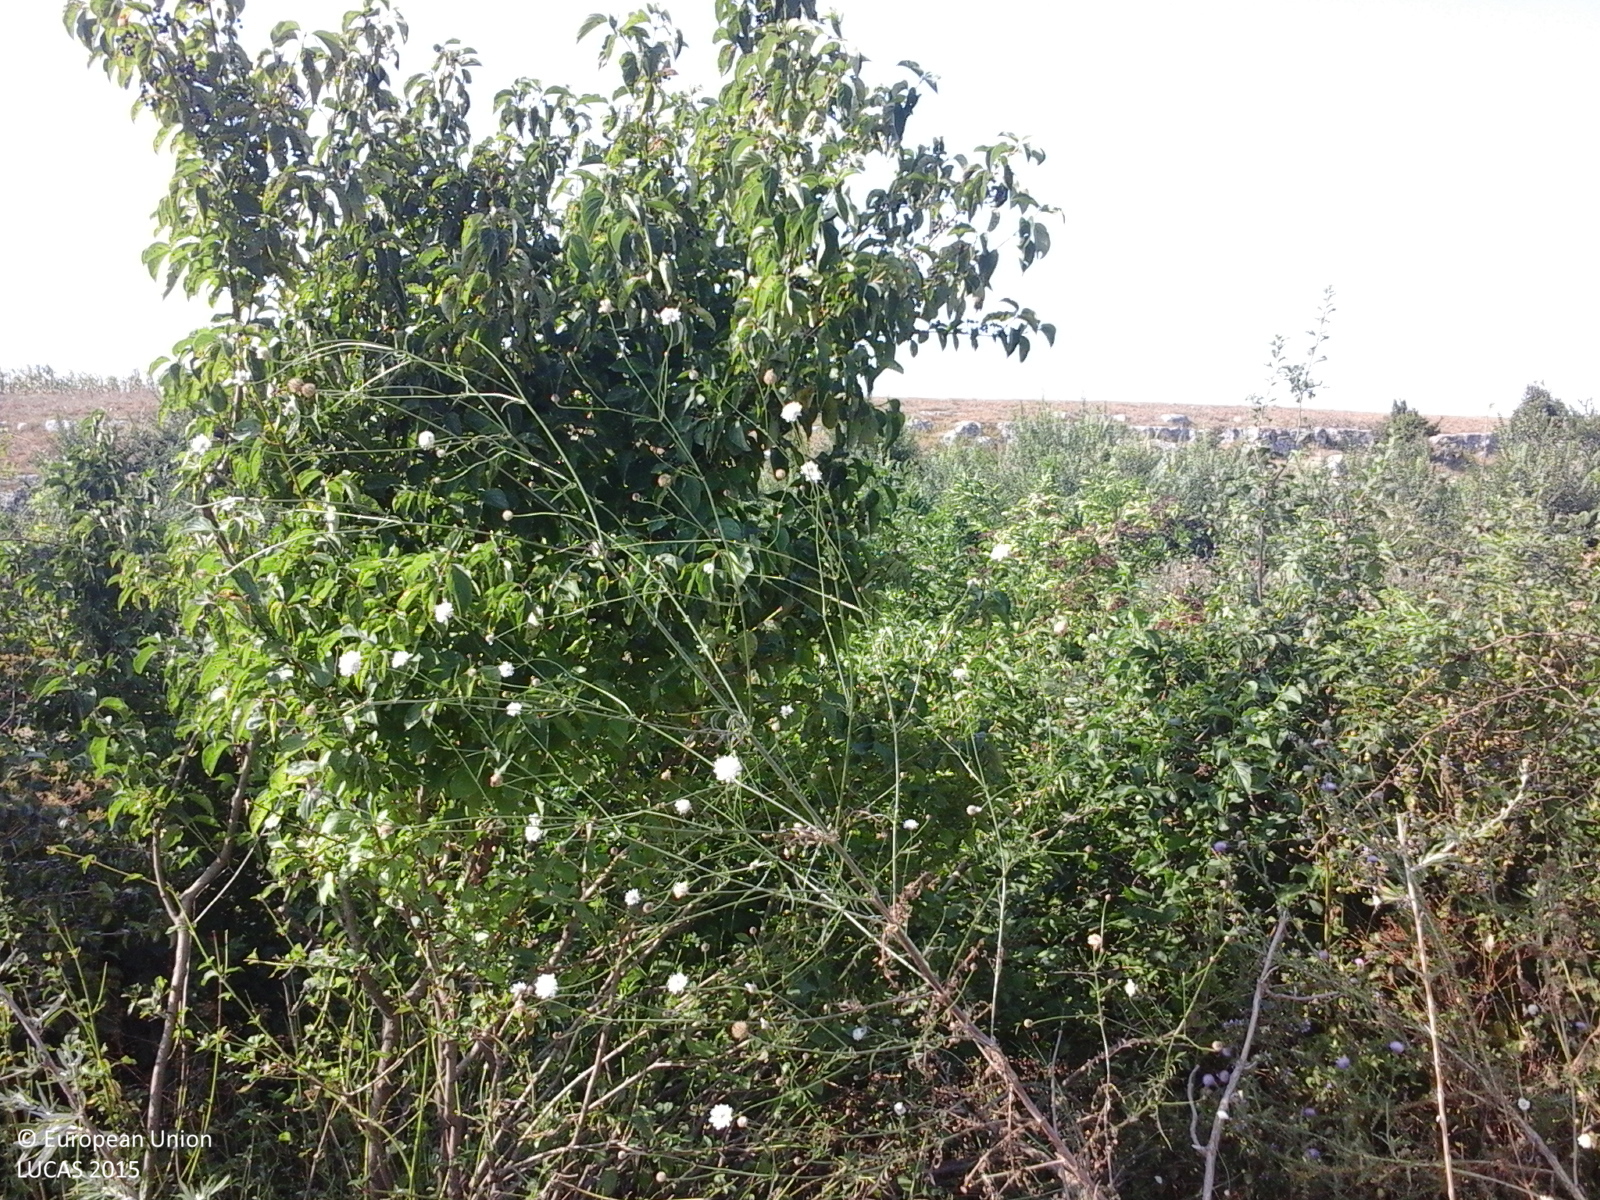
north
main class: Cropland
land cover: Common wheat
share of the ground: > 75 %
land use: Agriculture (excluding fallow land and kitchen gardens)
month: August
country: RO
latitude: 44.0842
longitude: 28.0248
